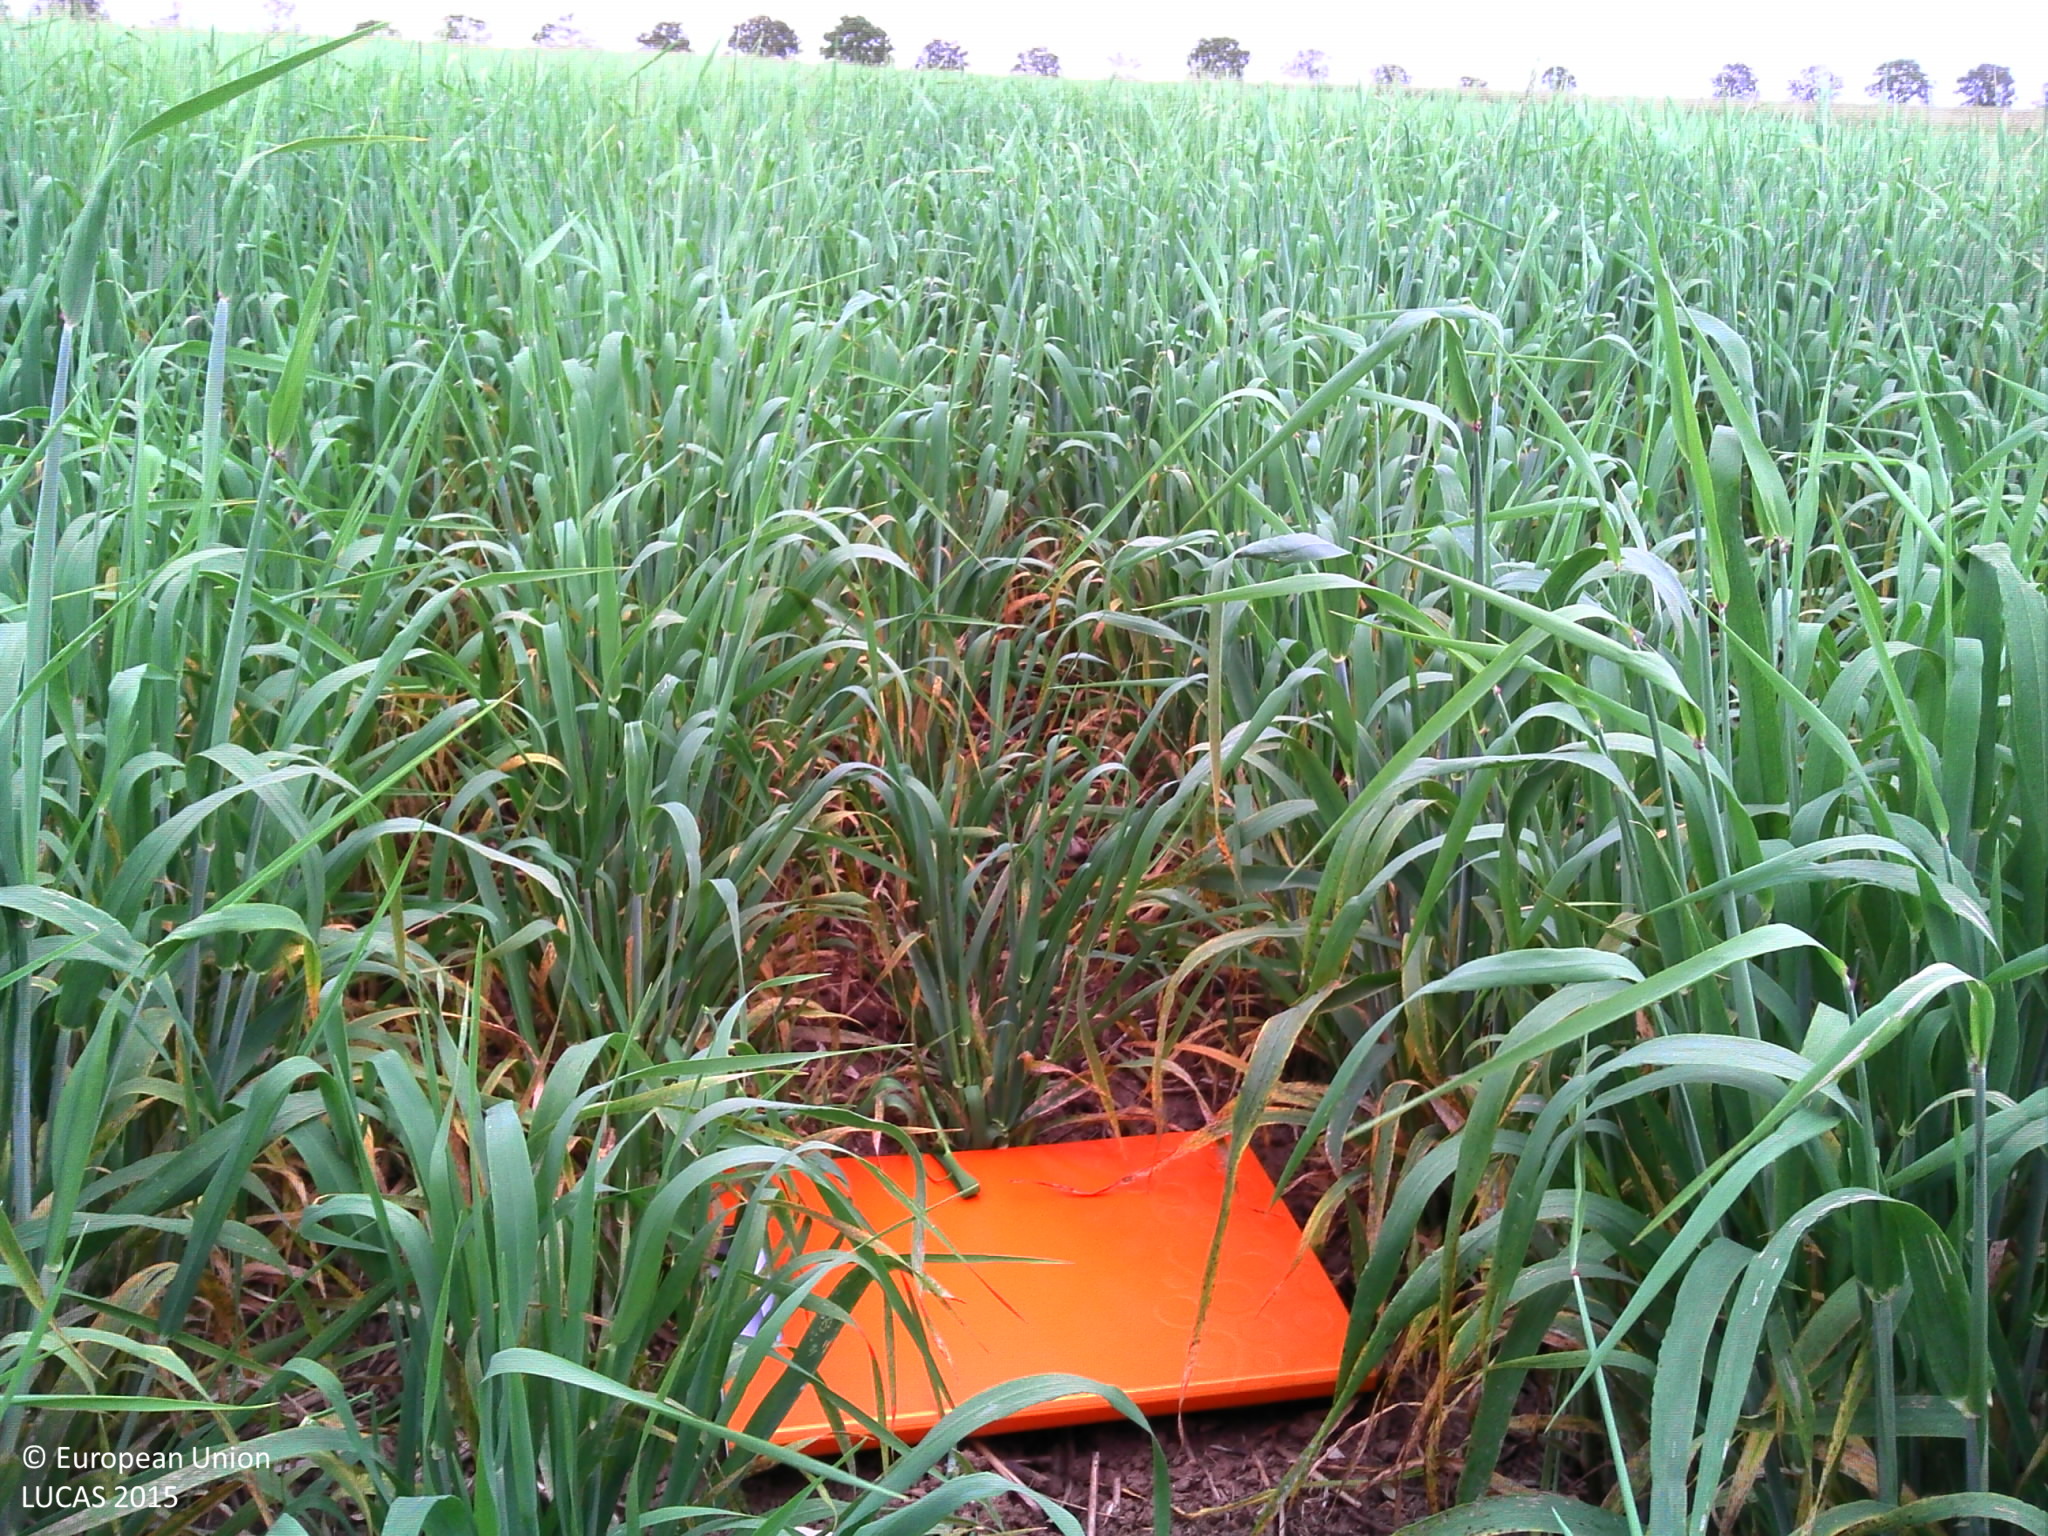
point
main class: Cropland
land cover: Barley
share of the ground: > 75 %
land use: Agriculture (excluding fallow land and kitchen gardens)
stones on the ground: 10 - 25 %
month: May
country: FR
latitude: 47.1502
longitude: 2.7009
